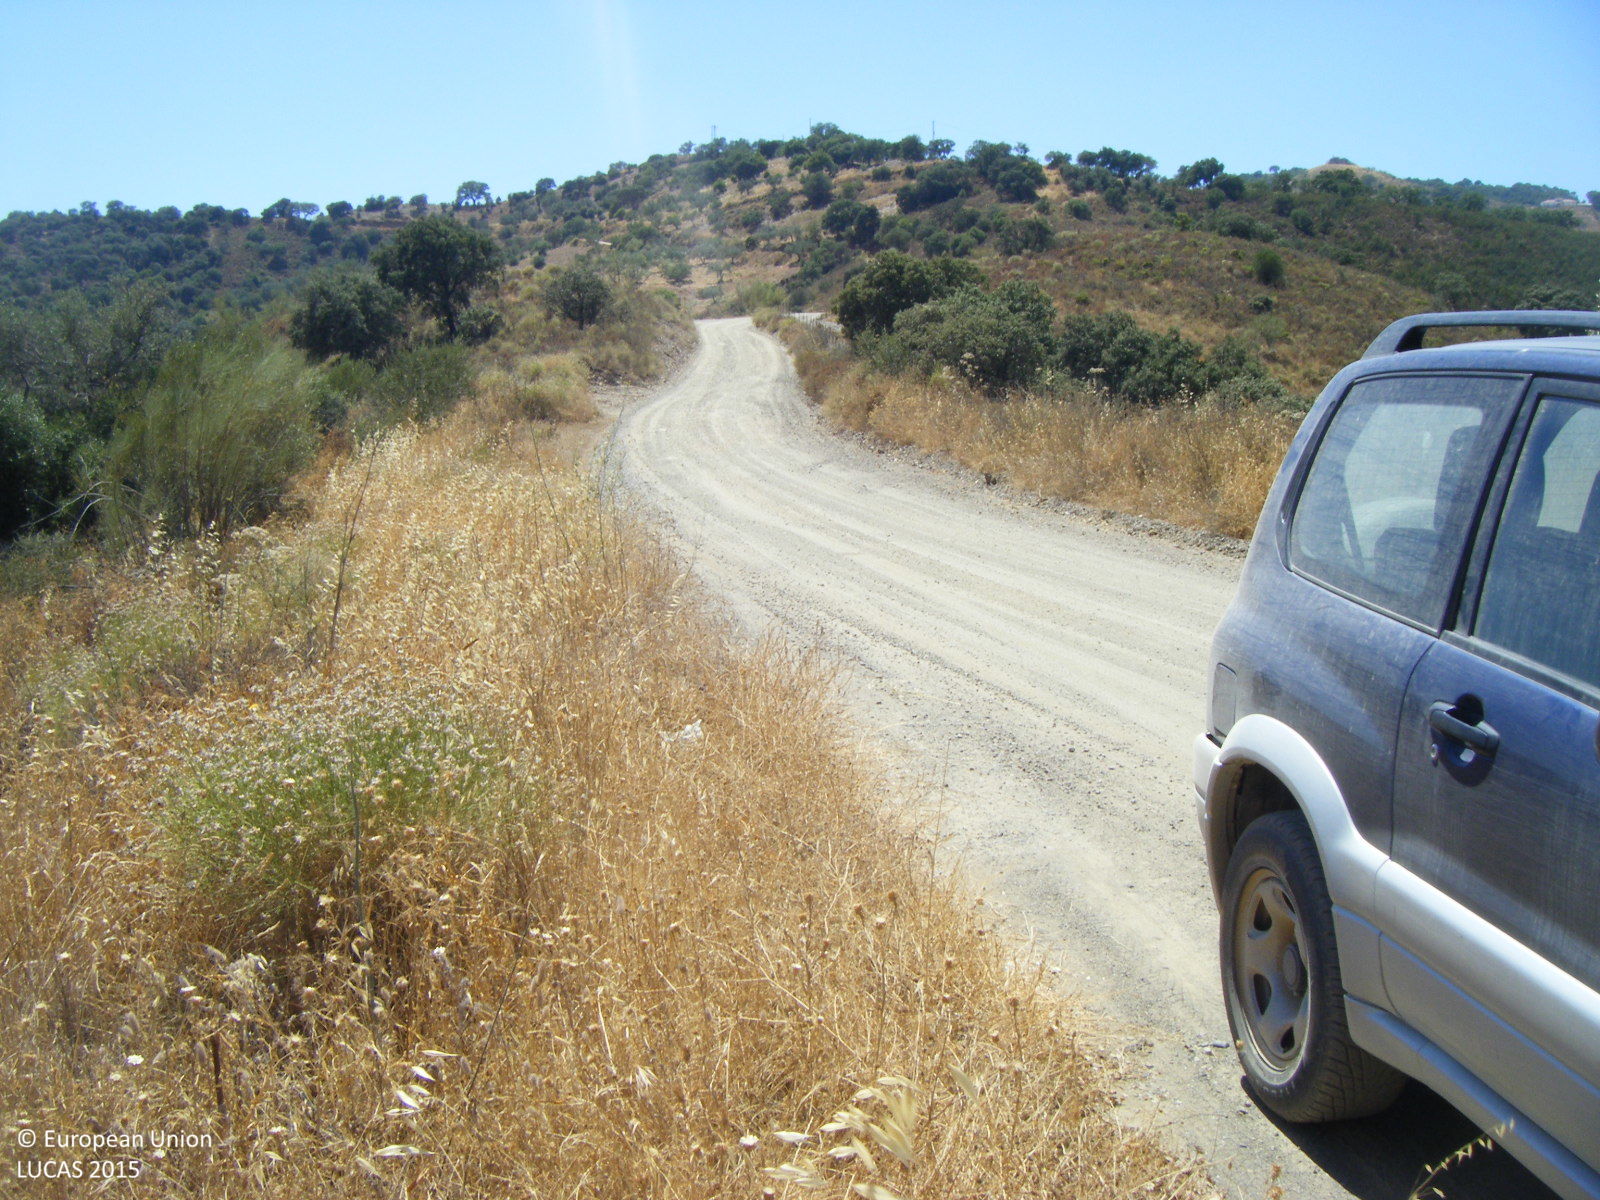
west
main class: Cropland
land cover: Nuts trees
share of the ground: 10 - 25 %
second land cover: Spontaneously vegetated surfaces
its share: > 75 %
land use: Abandoned areas
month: July
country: ES
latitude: 36.8395
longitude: -4.3330
